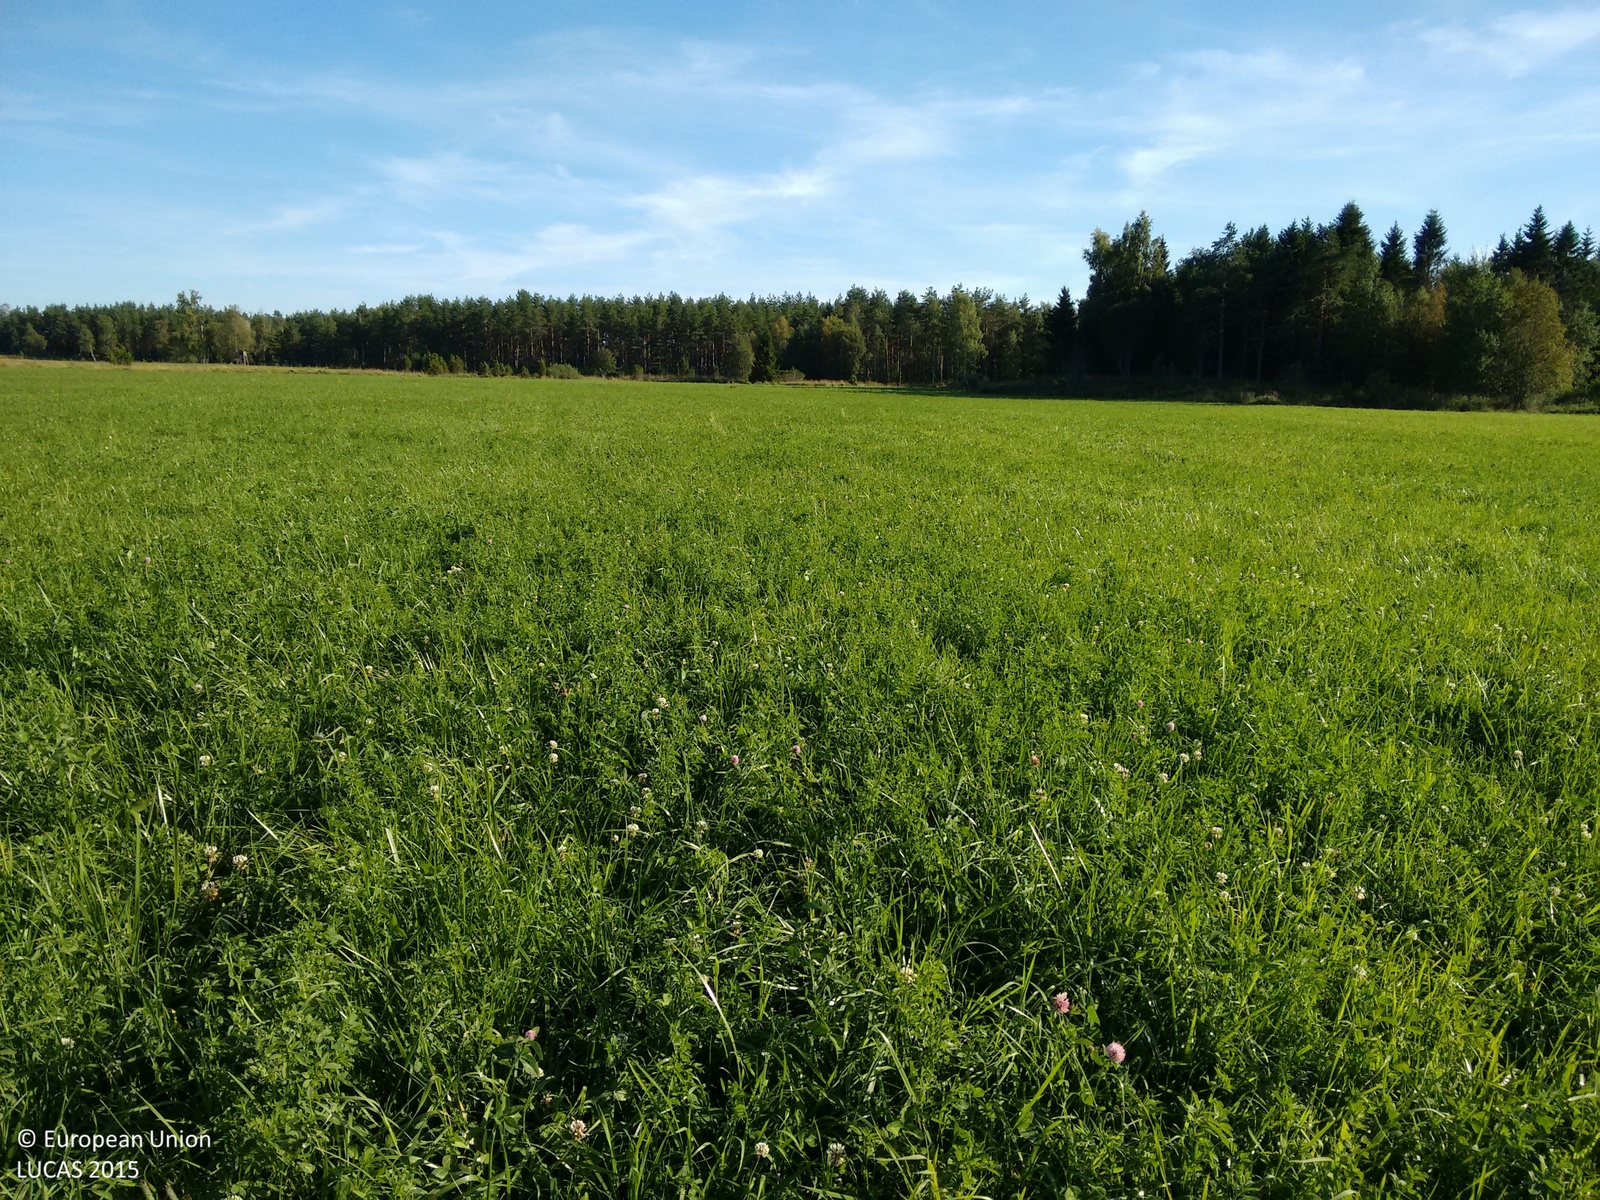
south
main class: Cropland
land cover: Temporary grasslands
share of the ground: > 75 %
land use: Agriculture (excluding fallow land and kitchen gardens)
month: August
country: FI
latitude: 60.1944
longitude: 19.9079
